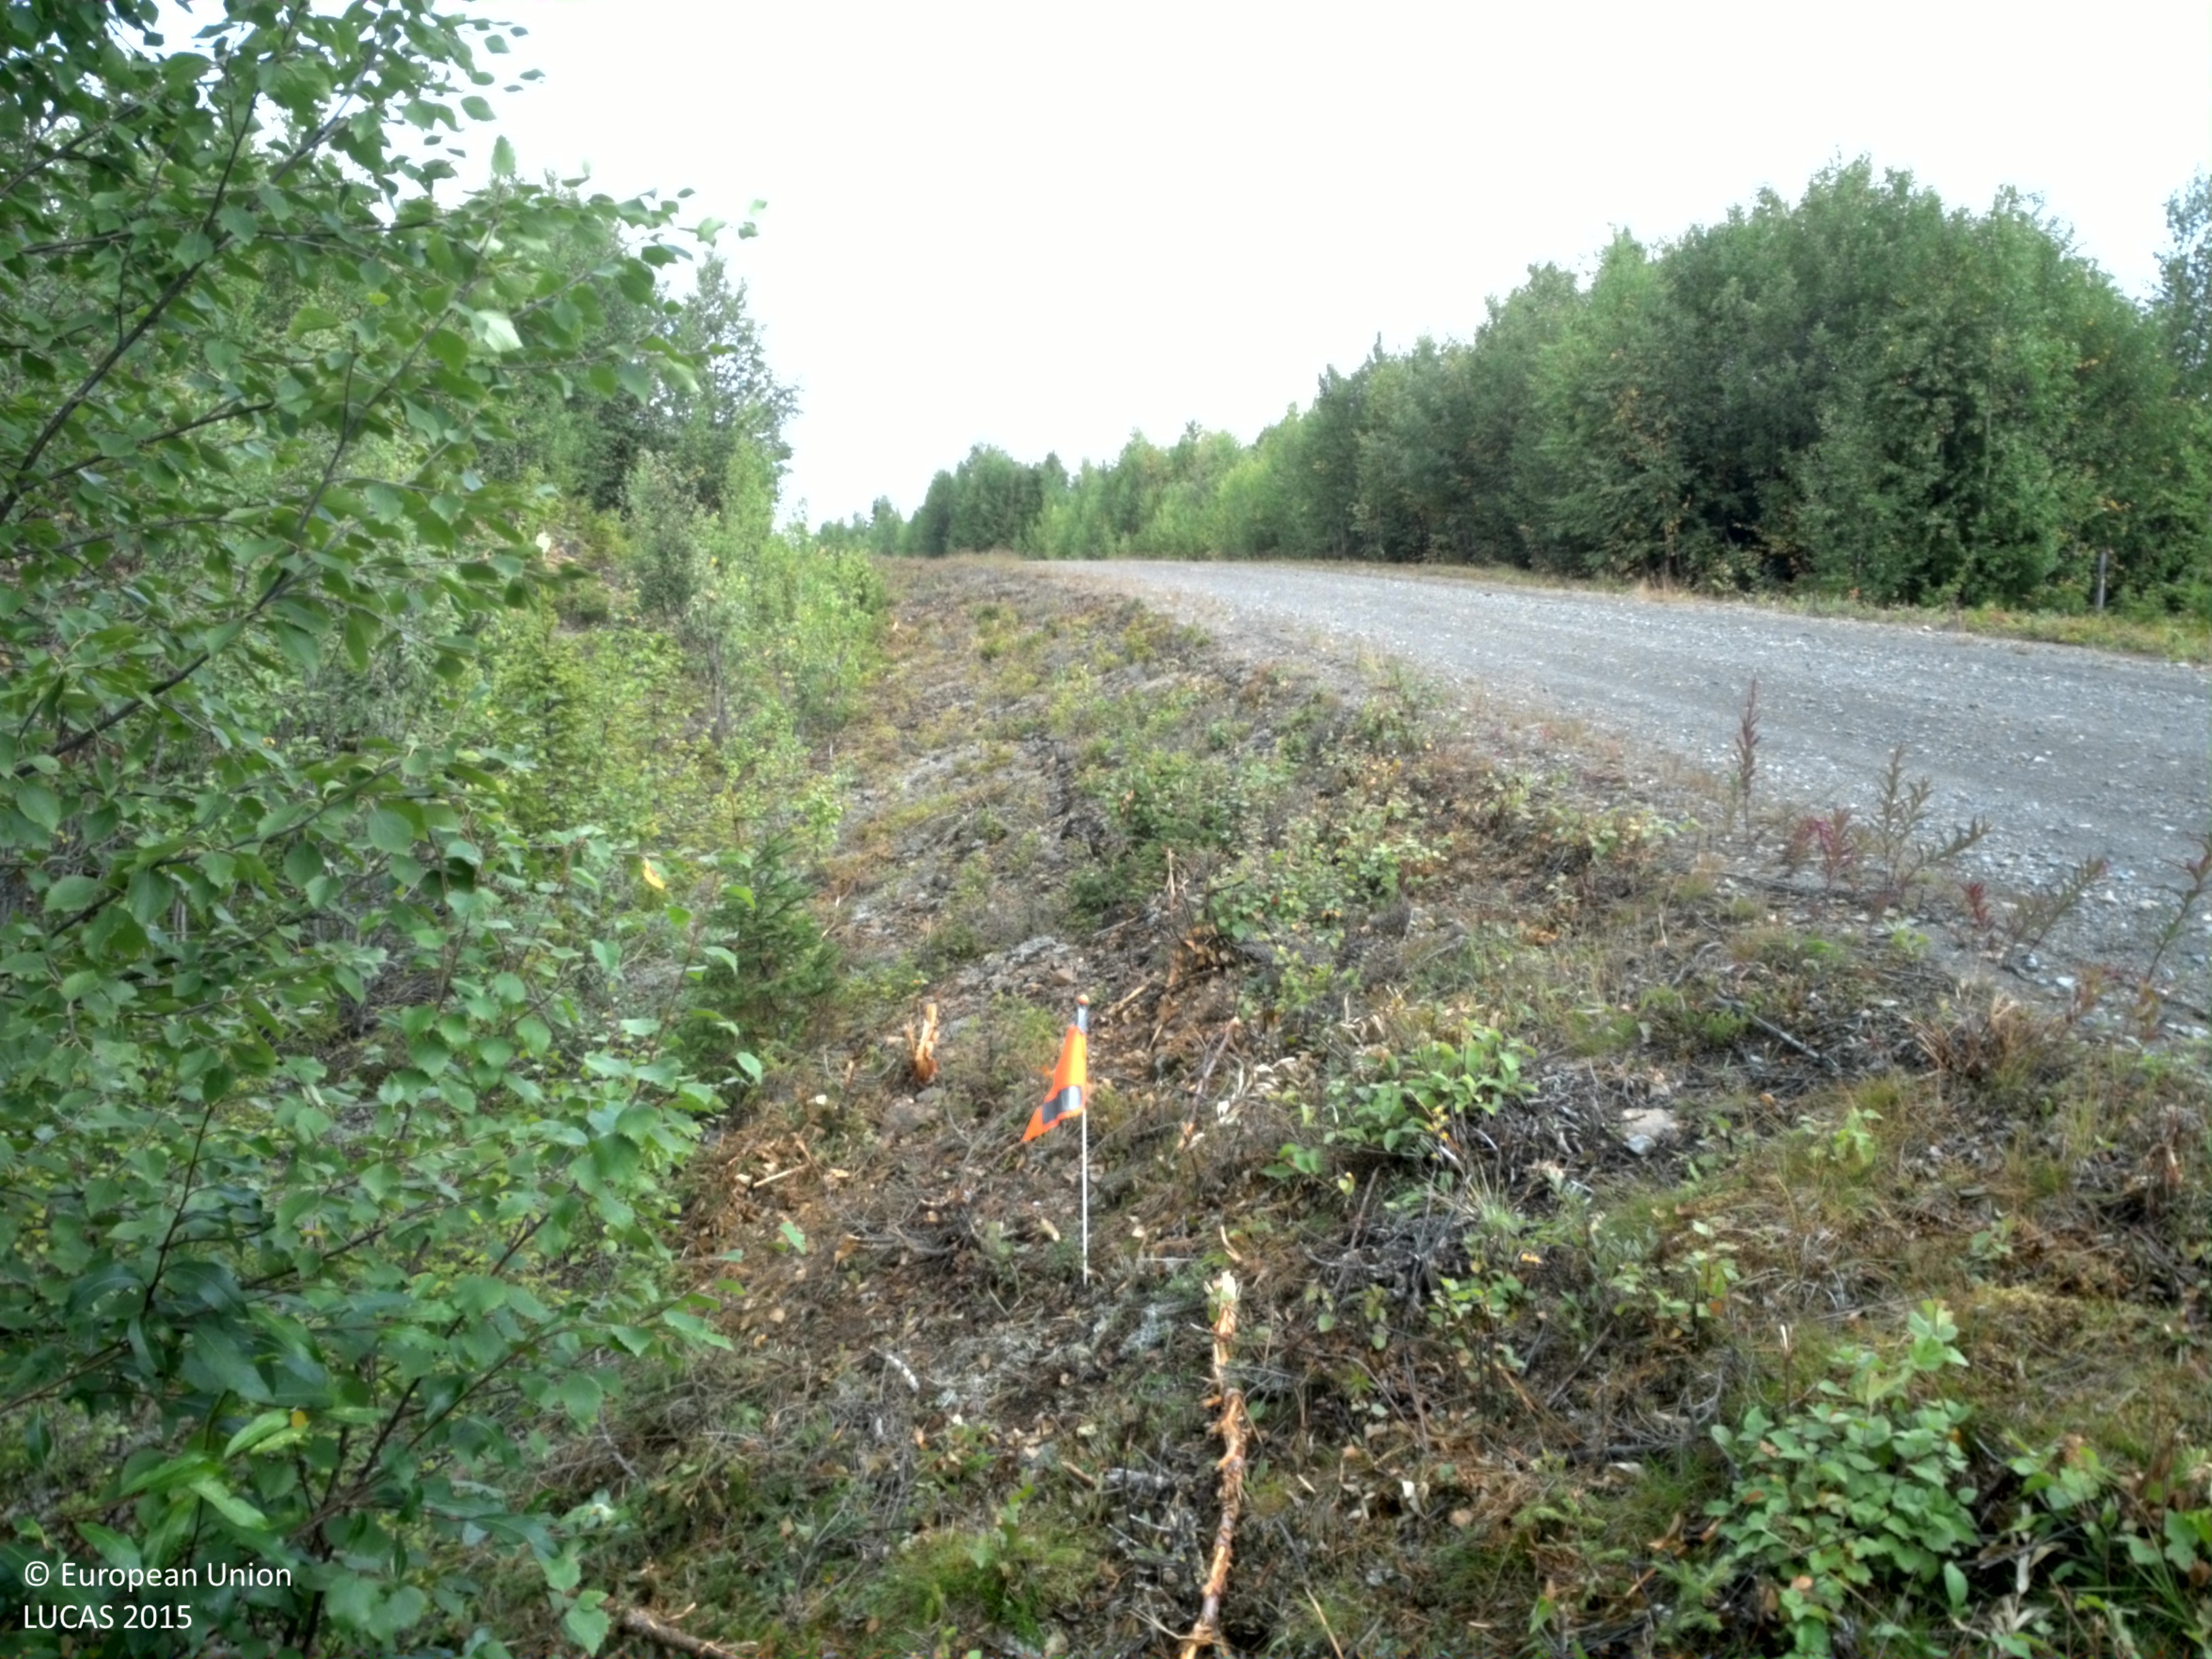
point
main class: Woodland
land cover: Spruce dominated mixed woodland
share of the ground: 10 - 25 %
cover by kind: unconsolidated bare surface 30 %, lichens and mosses 25 %, herbaceous plants 20 %, coniferous forest trees 10 %, shrubs 10 %, broadleaved forest trees 5 %
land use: Road transport
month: August
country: SE
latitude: 64.8099
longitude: 16.4727
